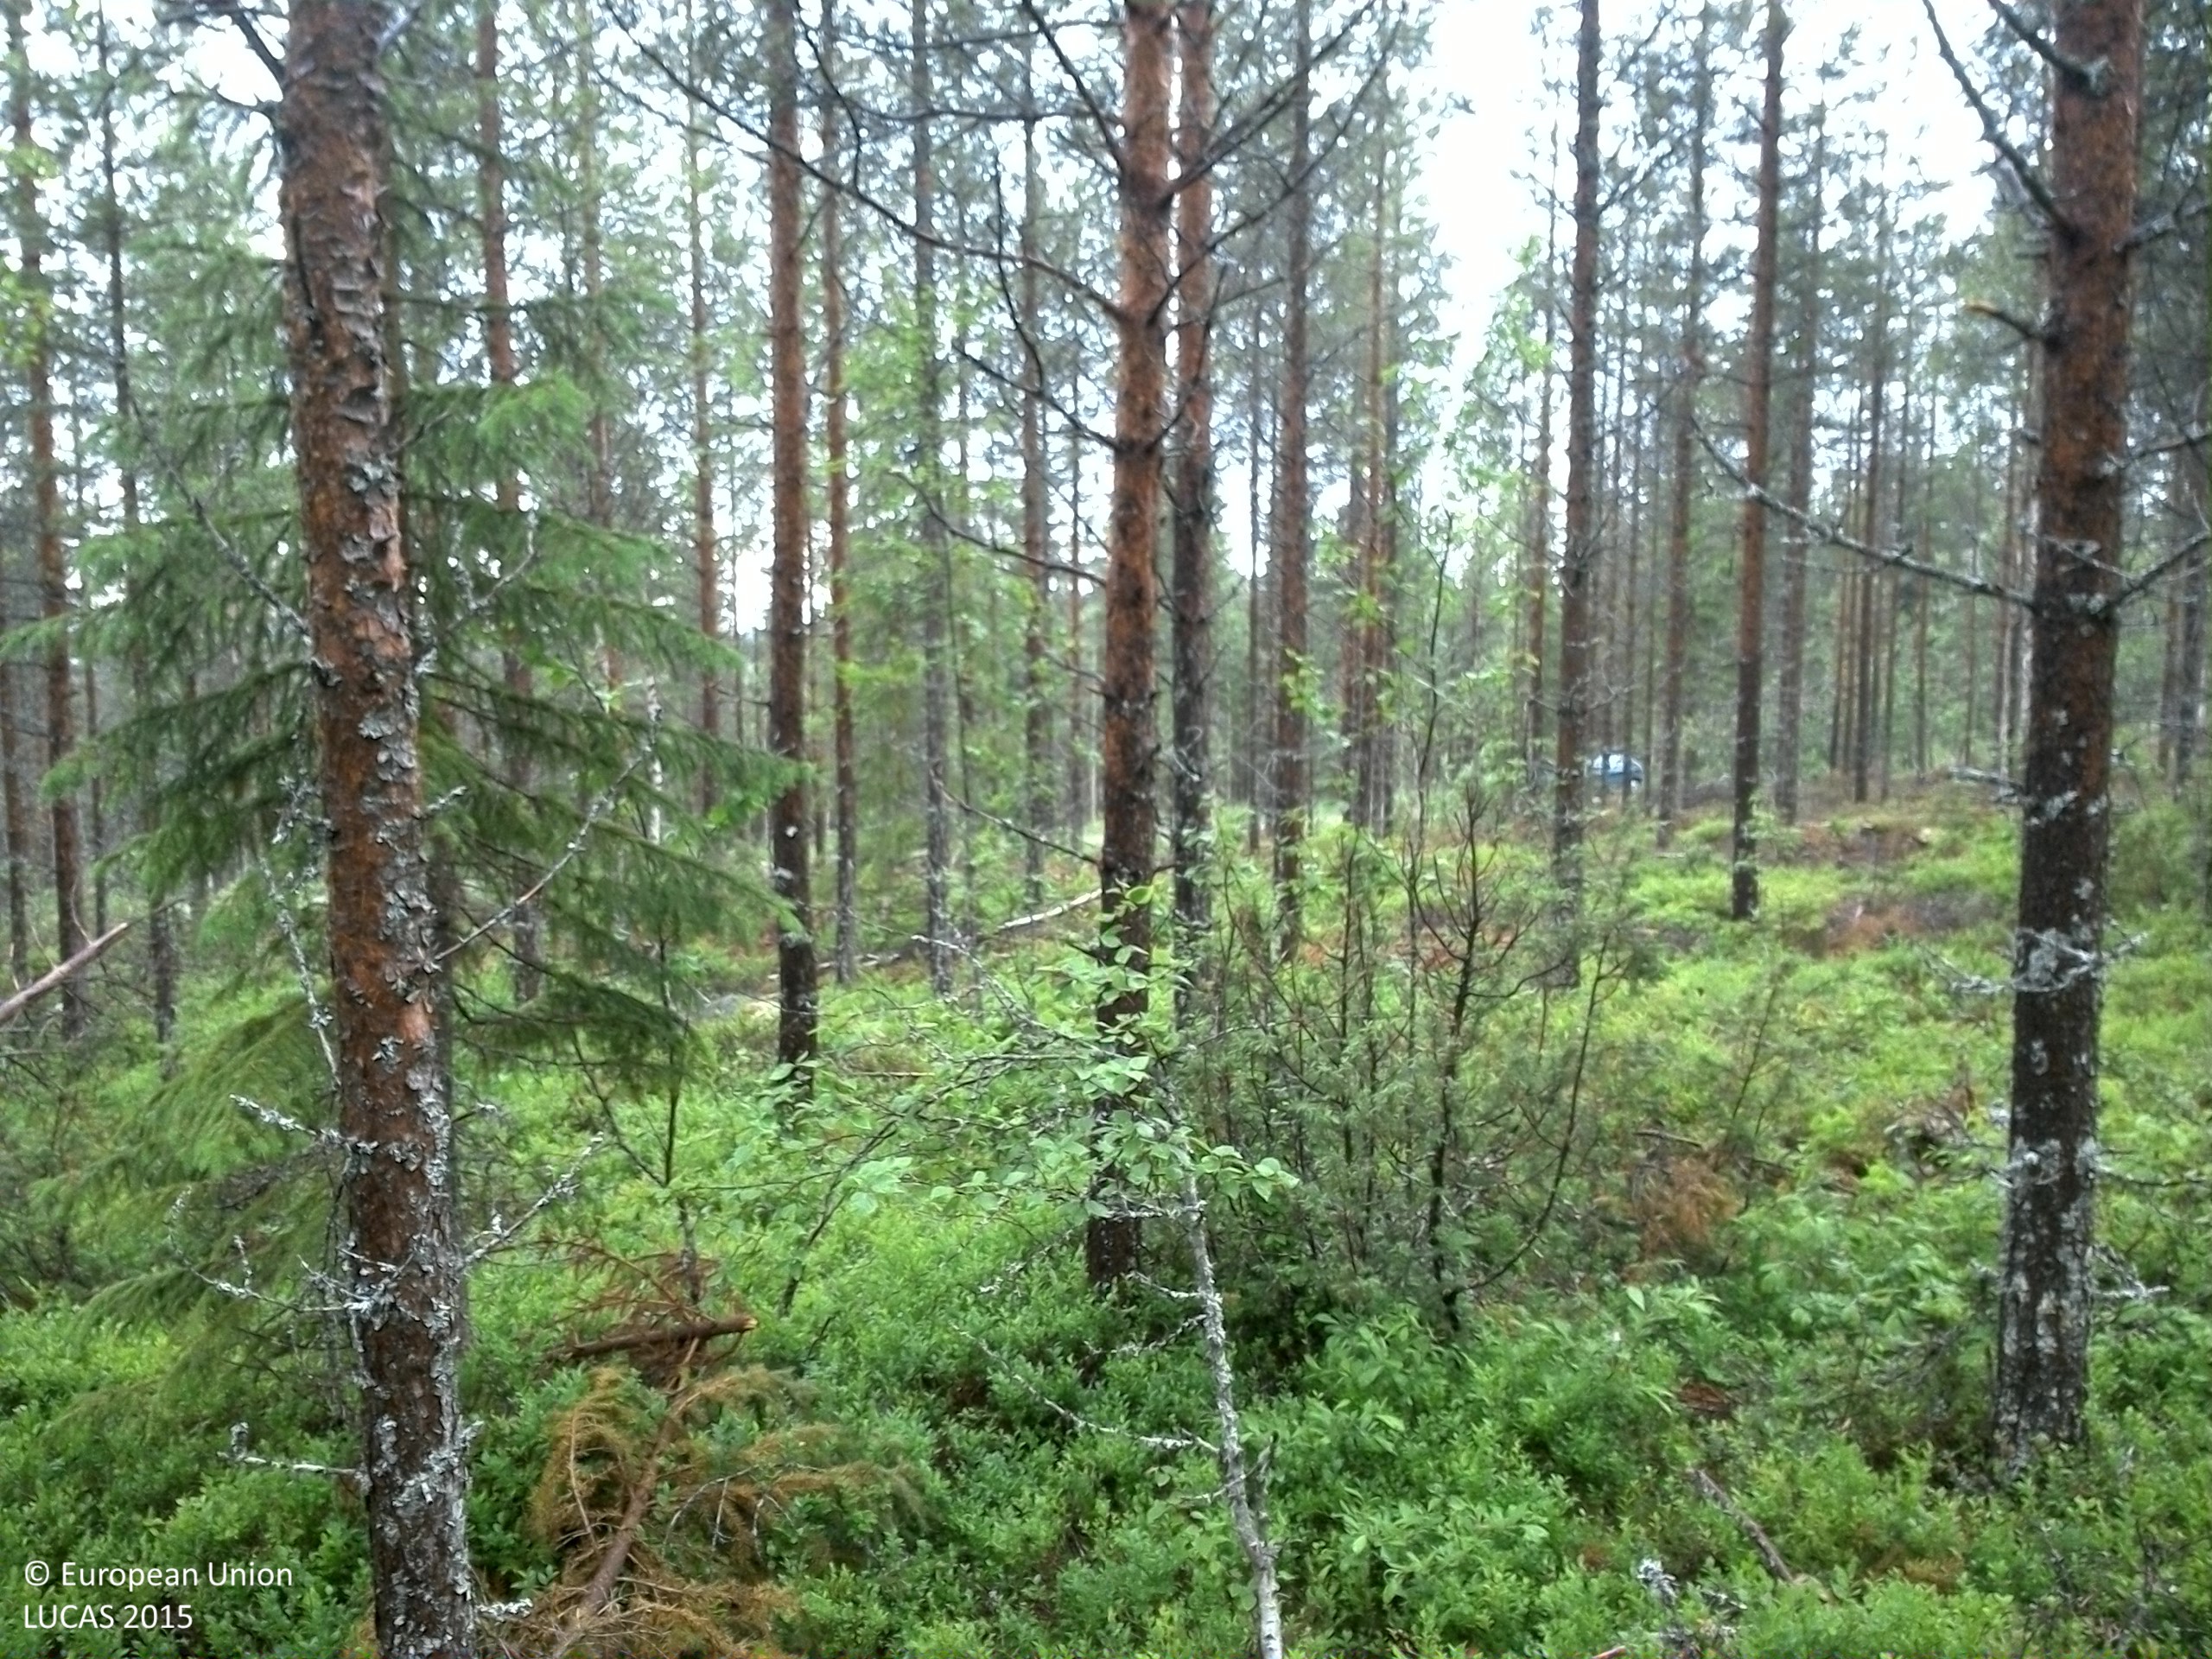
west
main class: Woodland
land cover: Pine dominated mixed woodland
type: boreal forest
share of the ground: 50 - 75 %
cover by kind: coniferous forest trees 45 %, shrubs 20 %, broadleaved forest trees 15 %, herbaceous plants 10 %, lichens and mosses 10 %
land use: Forestry
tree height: > 5 m
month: July
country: SE
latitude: 63.6693
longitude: 17.2676
